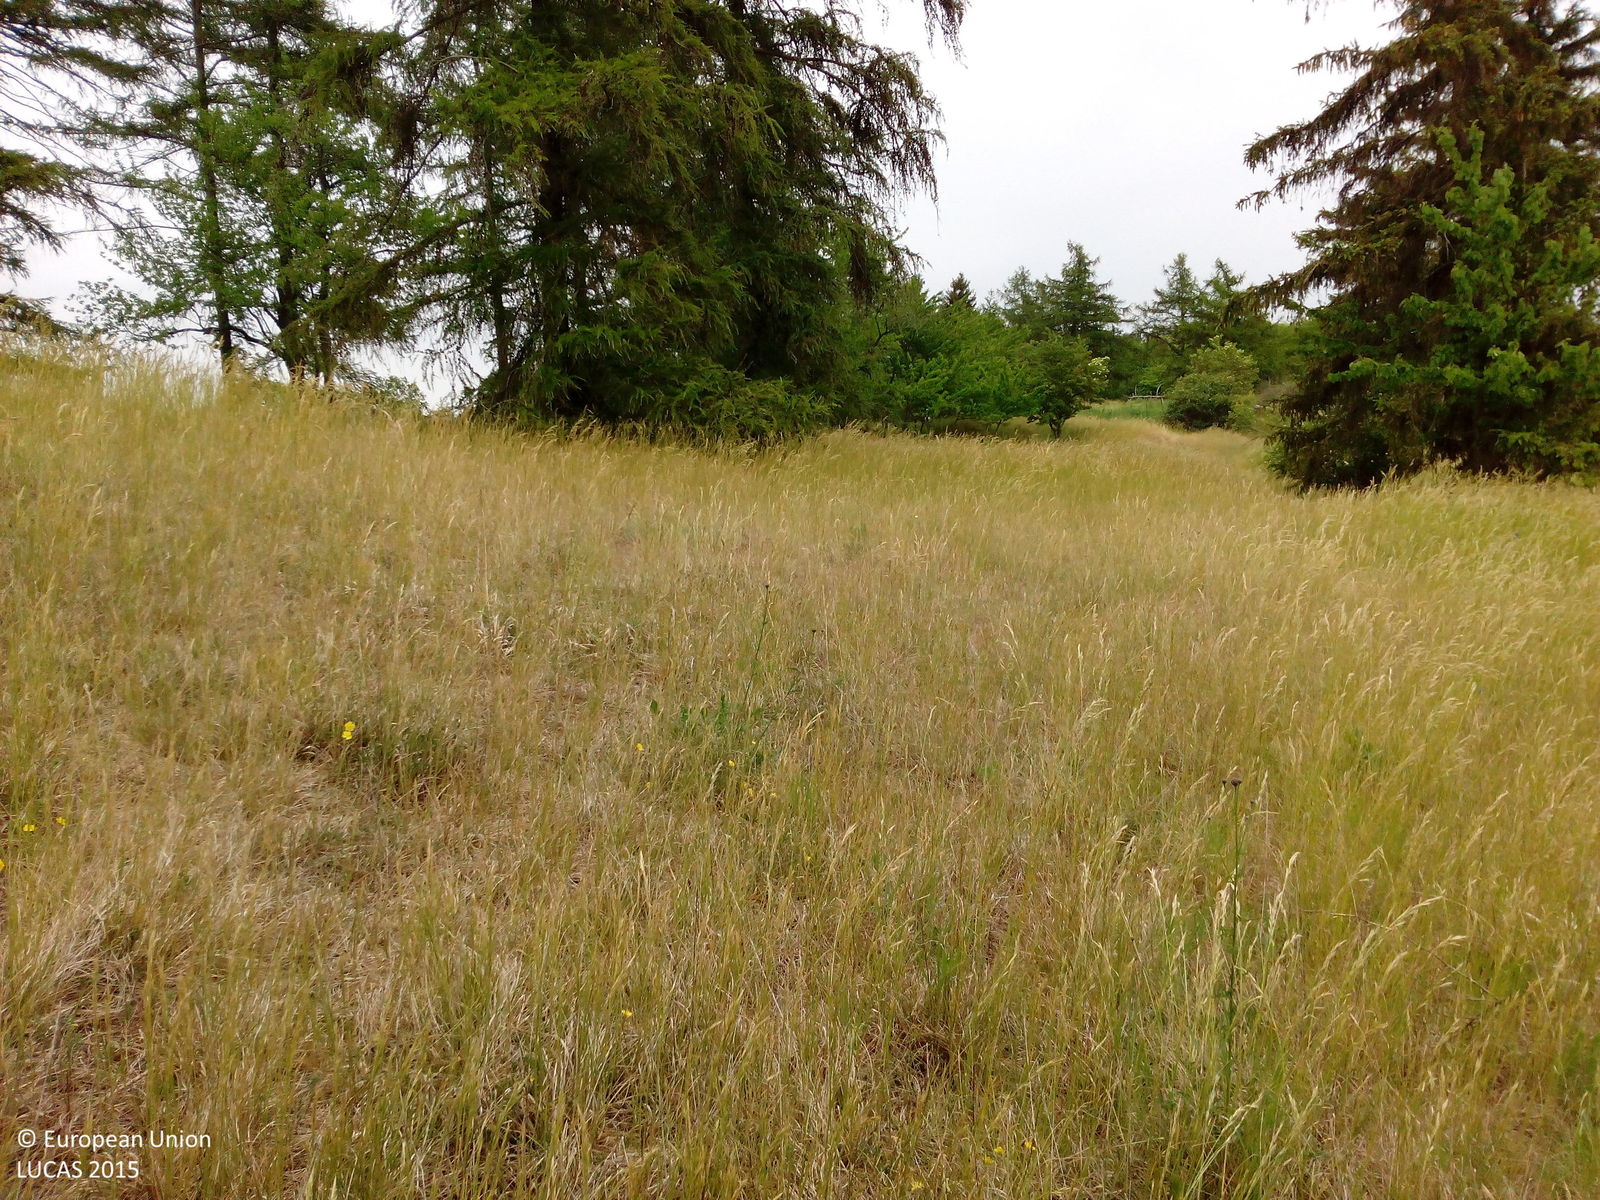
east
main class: Woodland
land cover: Spruce dominated coniferous woodland
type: hemiboreal forest and nemoral coniferous forest and mixed broadleaved-coniferous forest
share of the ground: 10 - 25 %
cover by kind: herbaceous plants 80 %, coniferous forest trees 15 %, shrubs 5 %
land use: Agriculture (excluding fallow land and kitchen gardens)
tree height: > 5 m
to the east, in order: Spruce dominated coniferous woodland; Tracks; Grass margins; Fences; Broadleaved woodland; Fences; Other mixed woodland; Shrubland with sparse tree cover; Grassland without tree/shrub cover
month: June
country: DE
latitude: 50.9915
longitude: 10.6409
